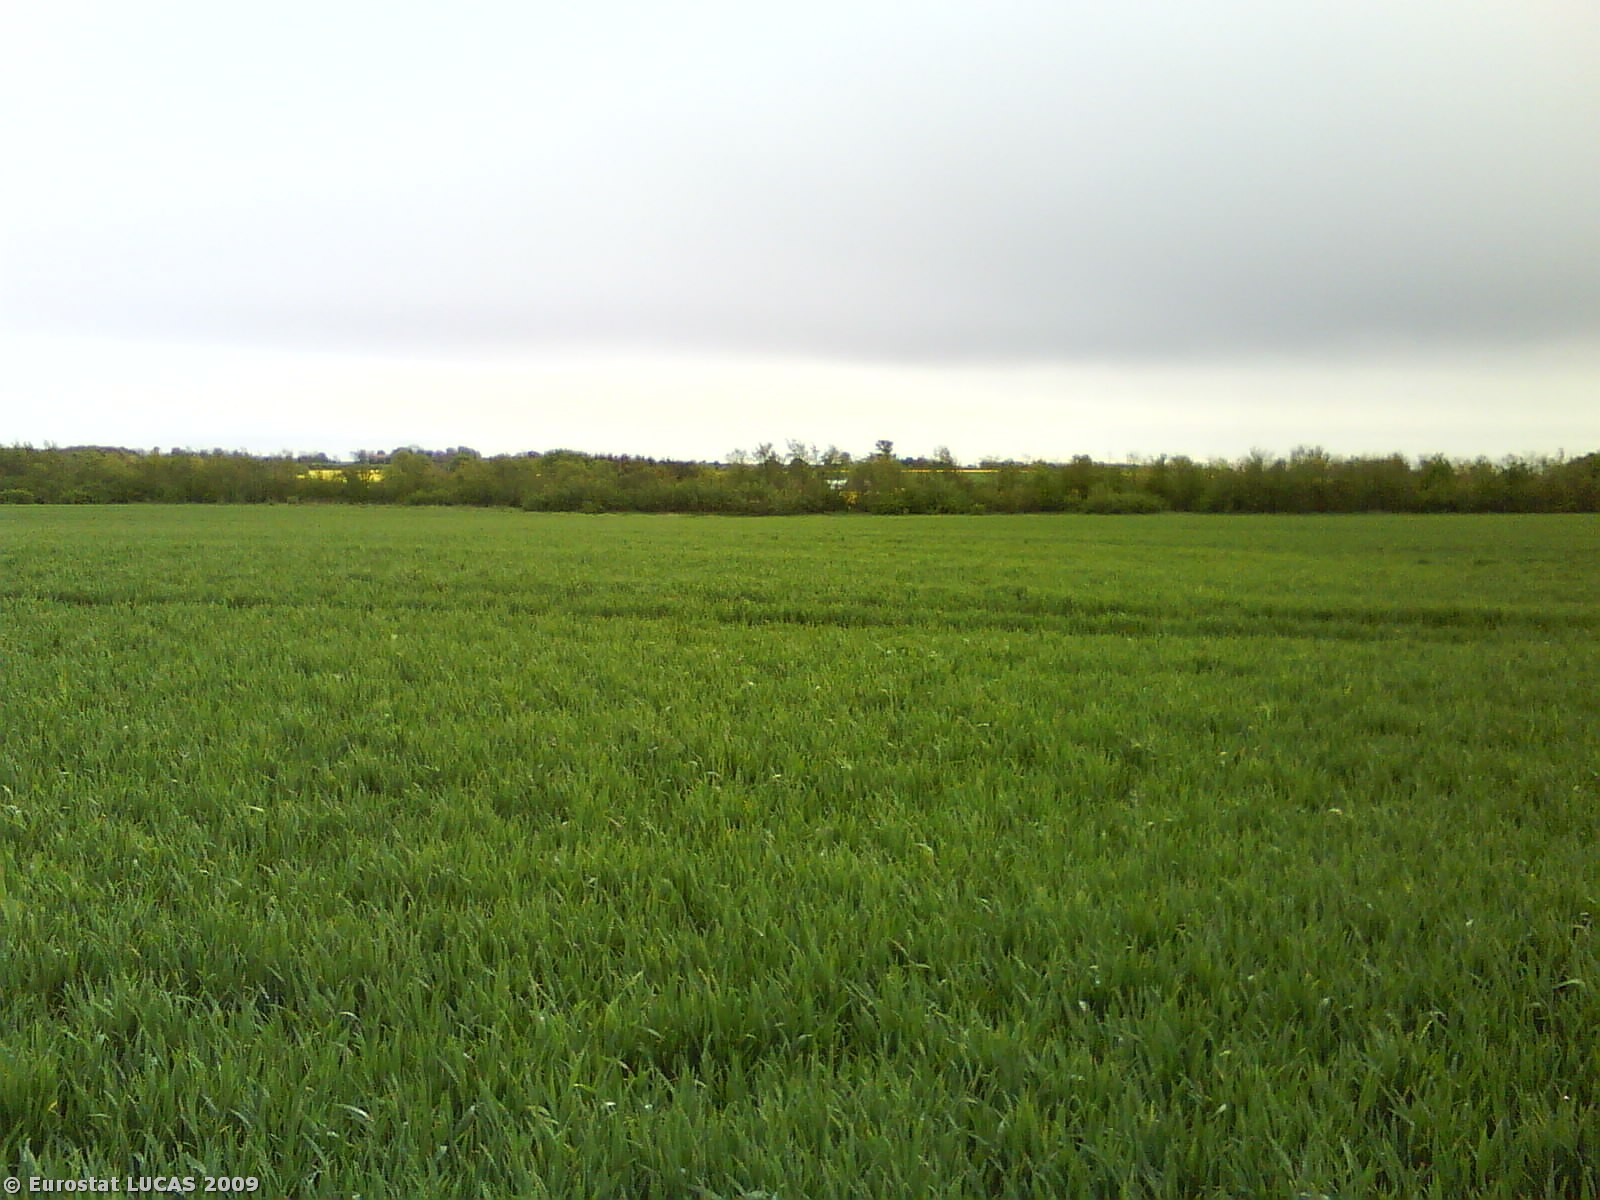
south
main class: Cropland
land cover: Common wheat
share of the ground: > 75 %
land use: Agriculture (excluding fallow land and kitchen gardens)
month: May
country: DK
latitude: 56.3314
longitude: 10.2100
